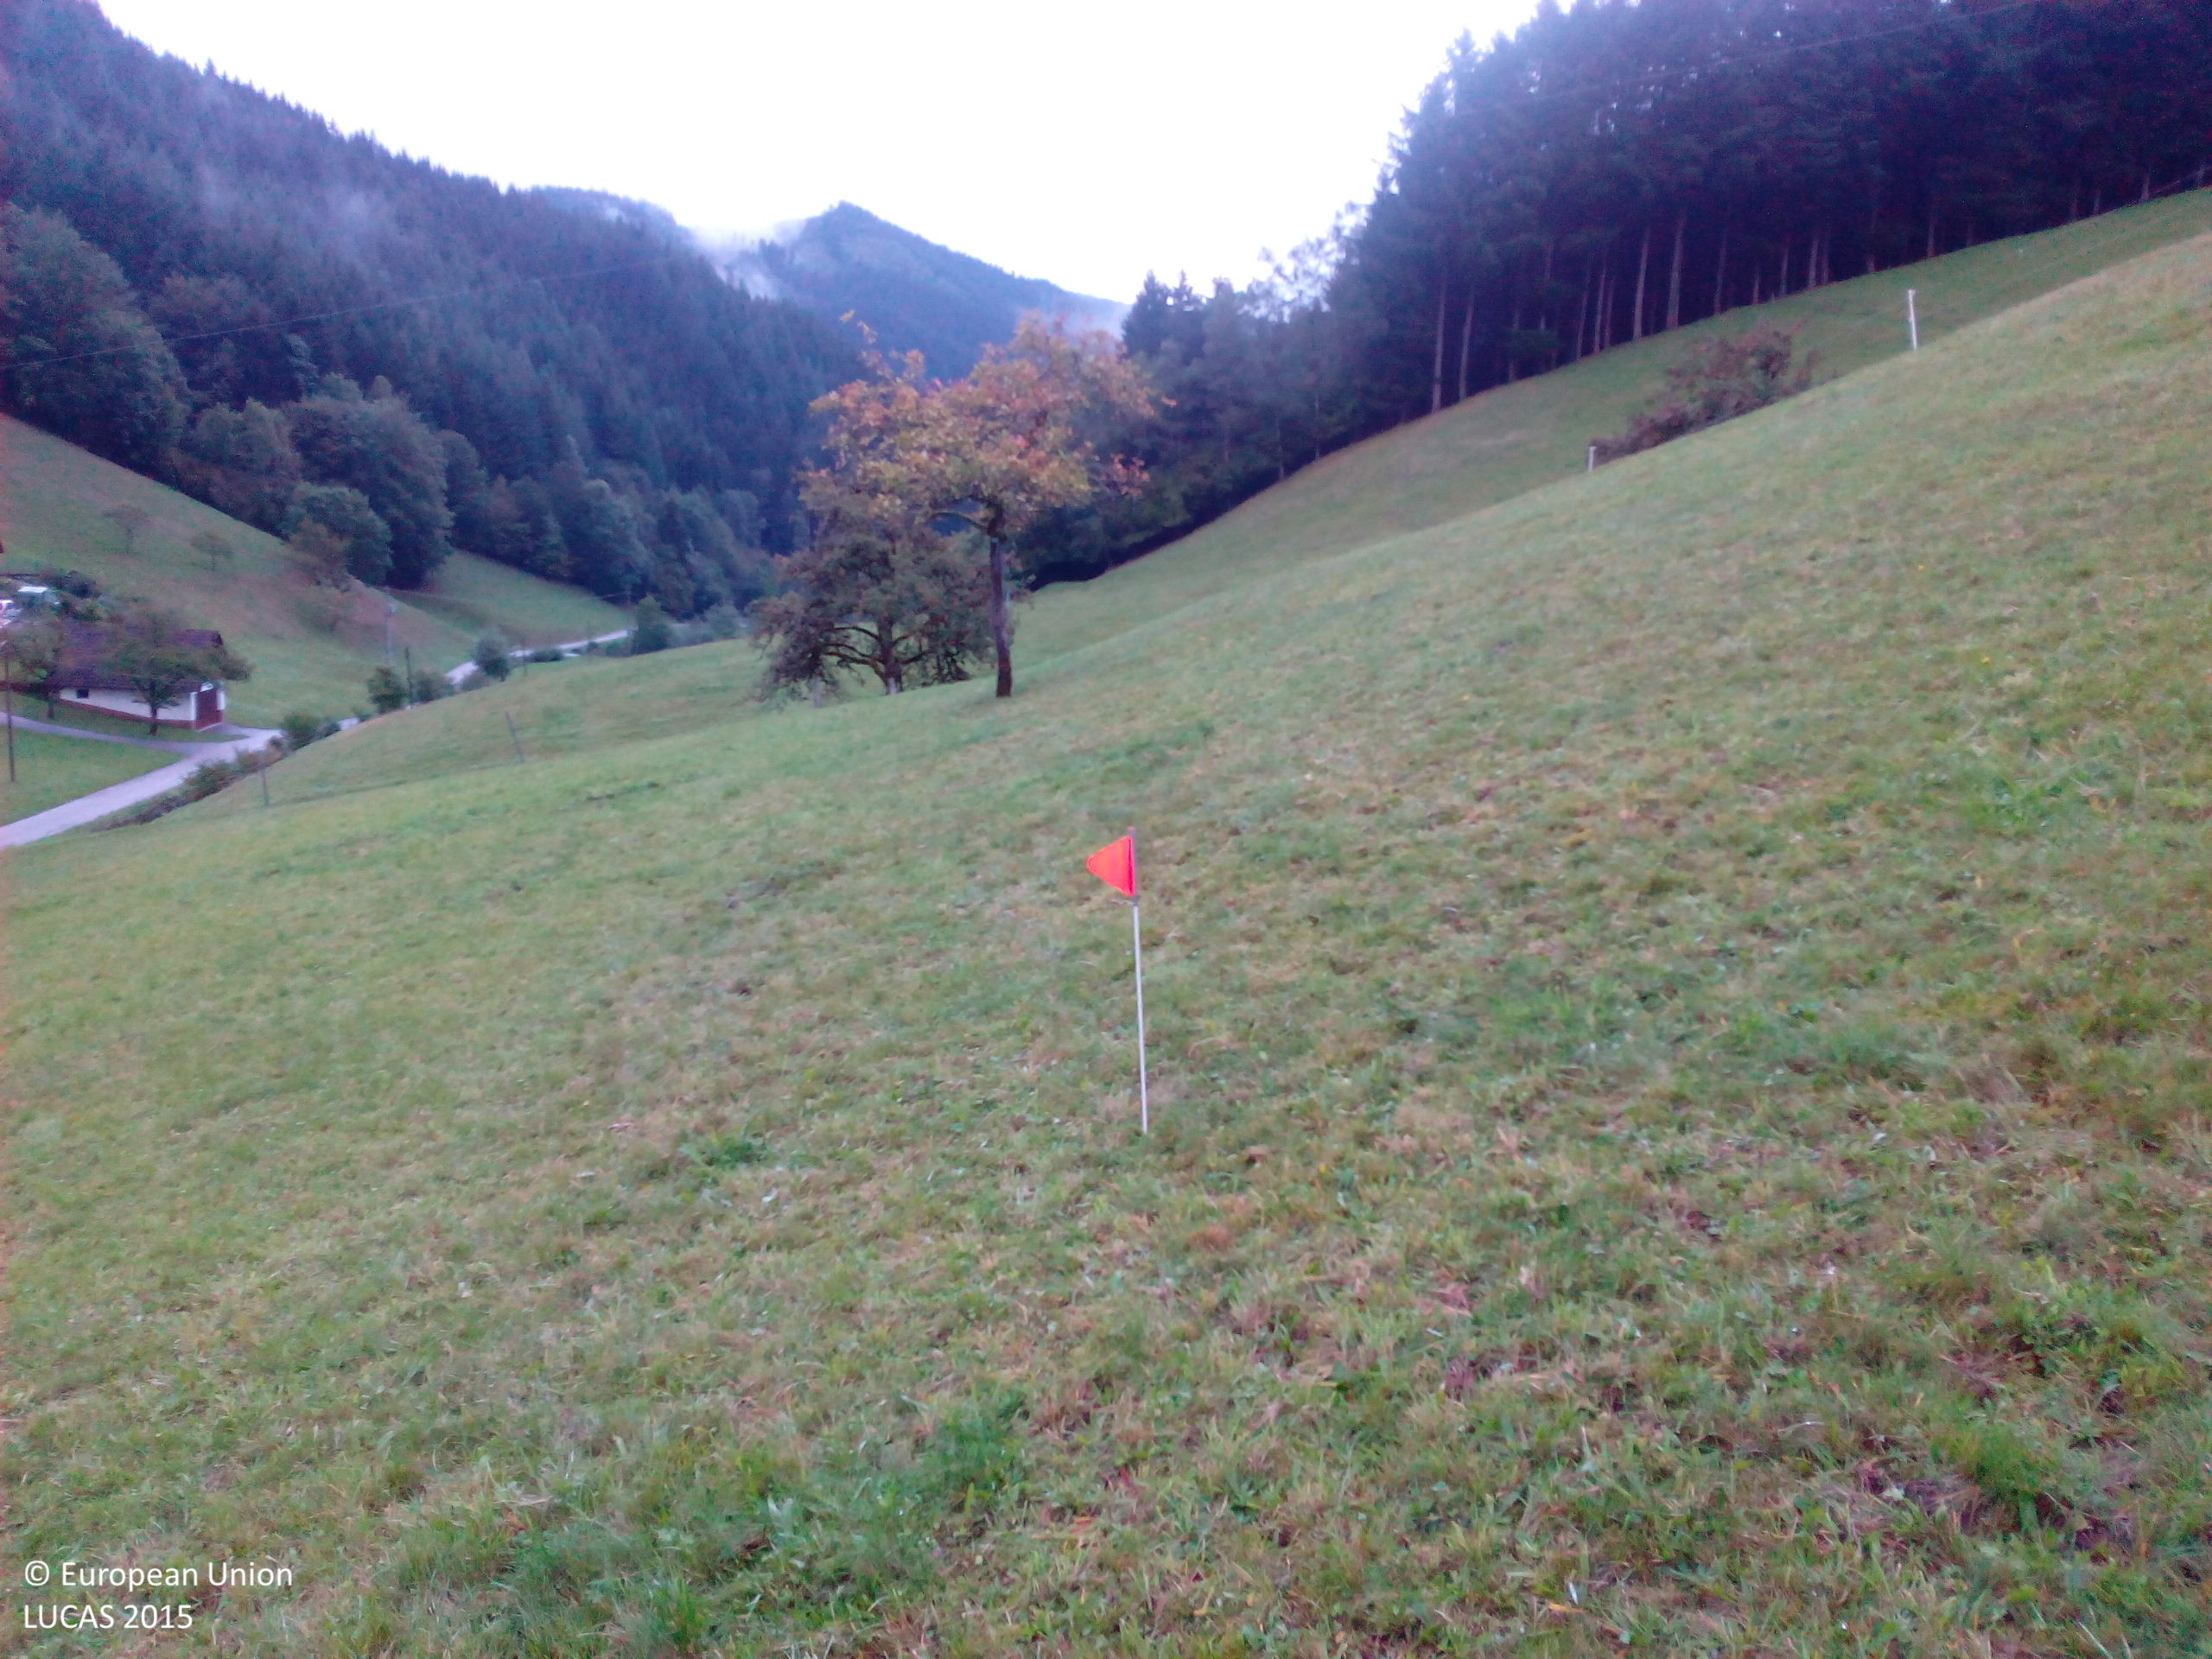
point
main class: Grassland
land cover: Grassland without tree/shrub cover
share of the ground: > 75 %
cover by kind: herbaceous plants 100 %
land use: Agriculture (excluding fallow land and kitchen gardens)
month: September
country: DE
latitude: 48.3709
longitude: 8.2054
